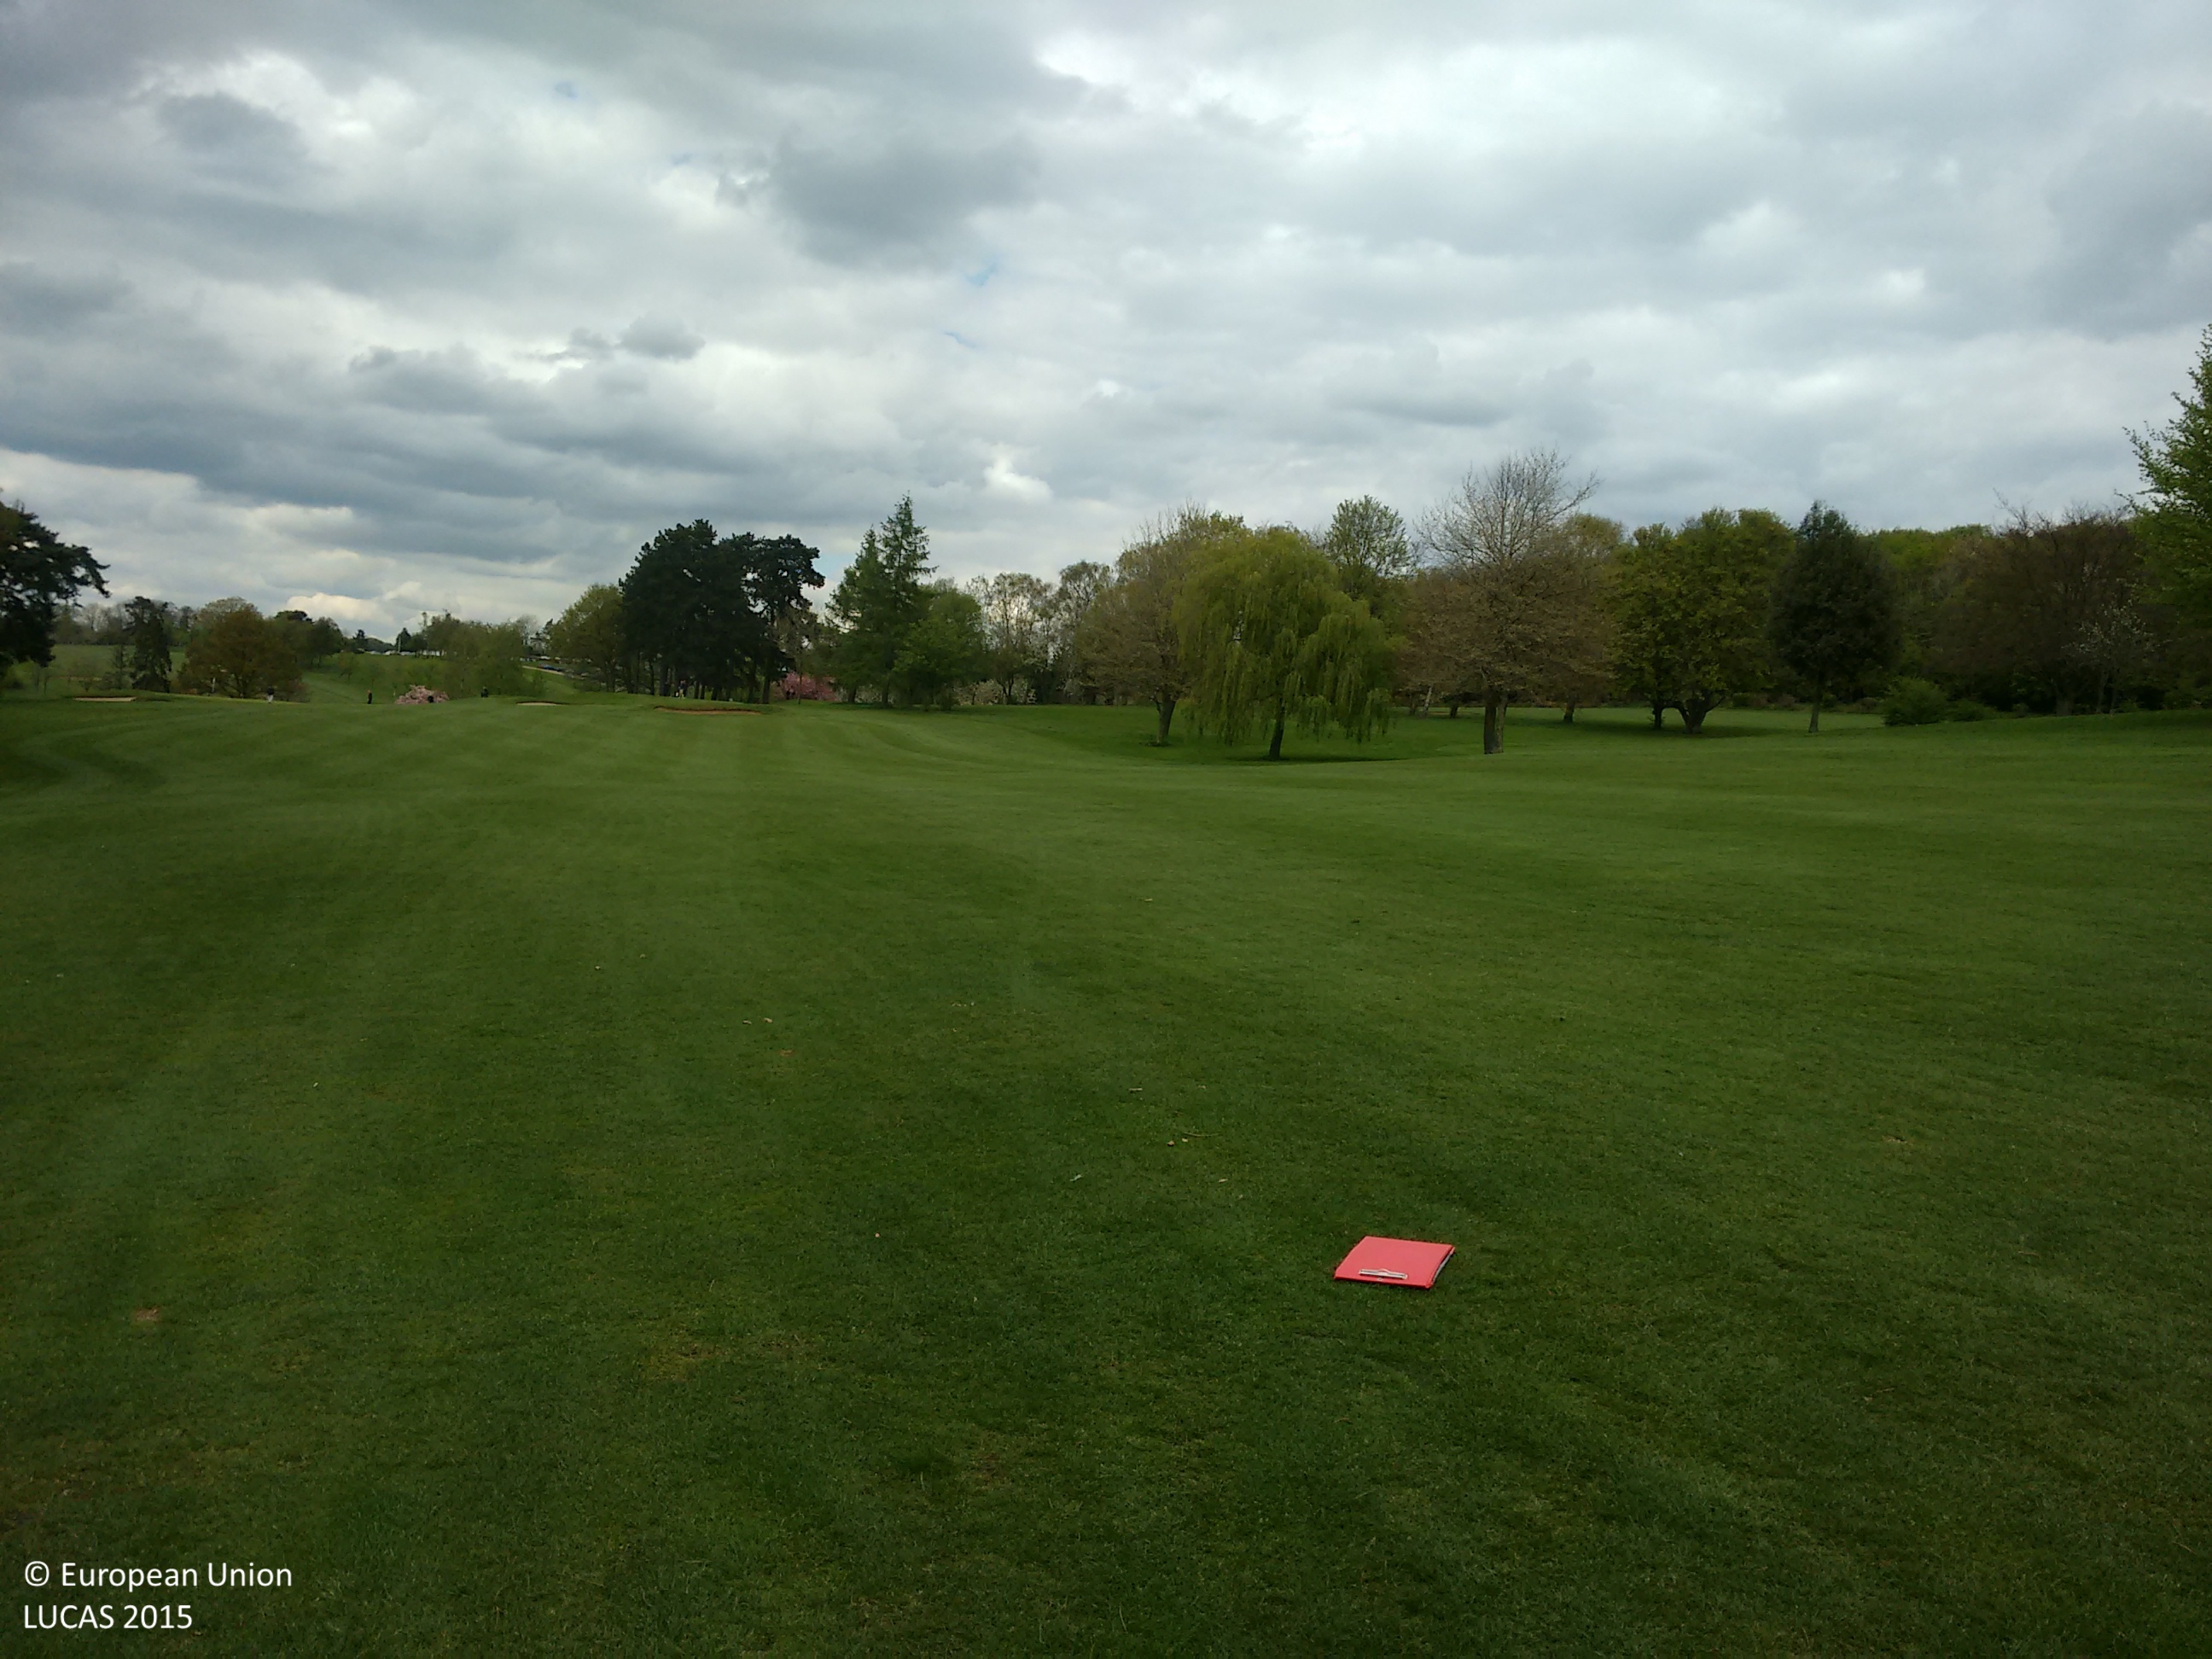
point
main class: Grassland
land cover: Grassland without tree/shrub cover
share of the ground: > 75 %
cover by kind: herbaceous plants 100 %
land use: Sport
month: April
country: GB
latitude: 51.6498
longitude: -0.5755
